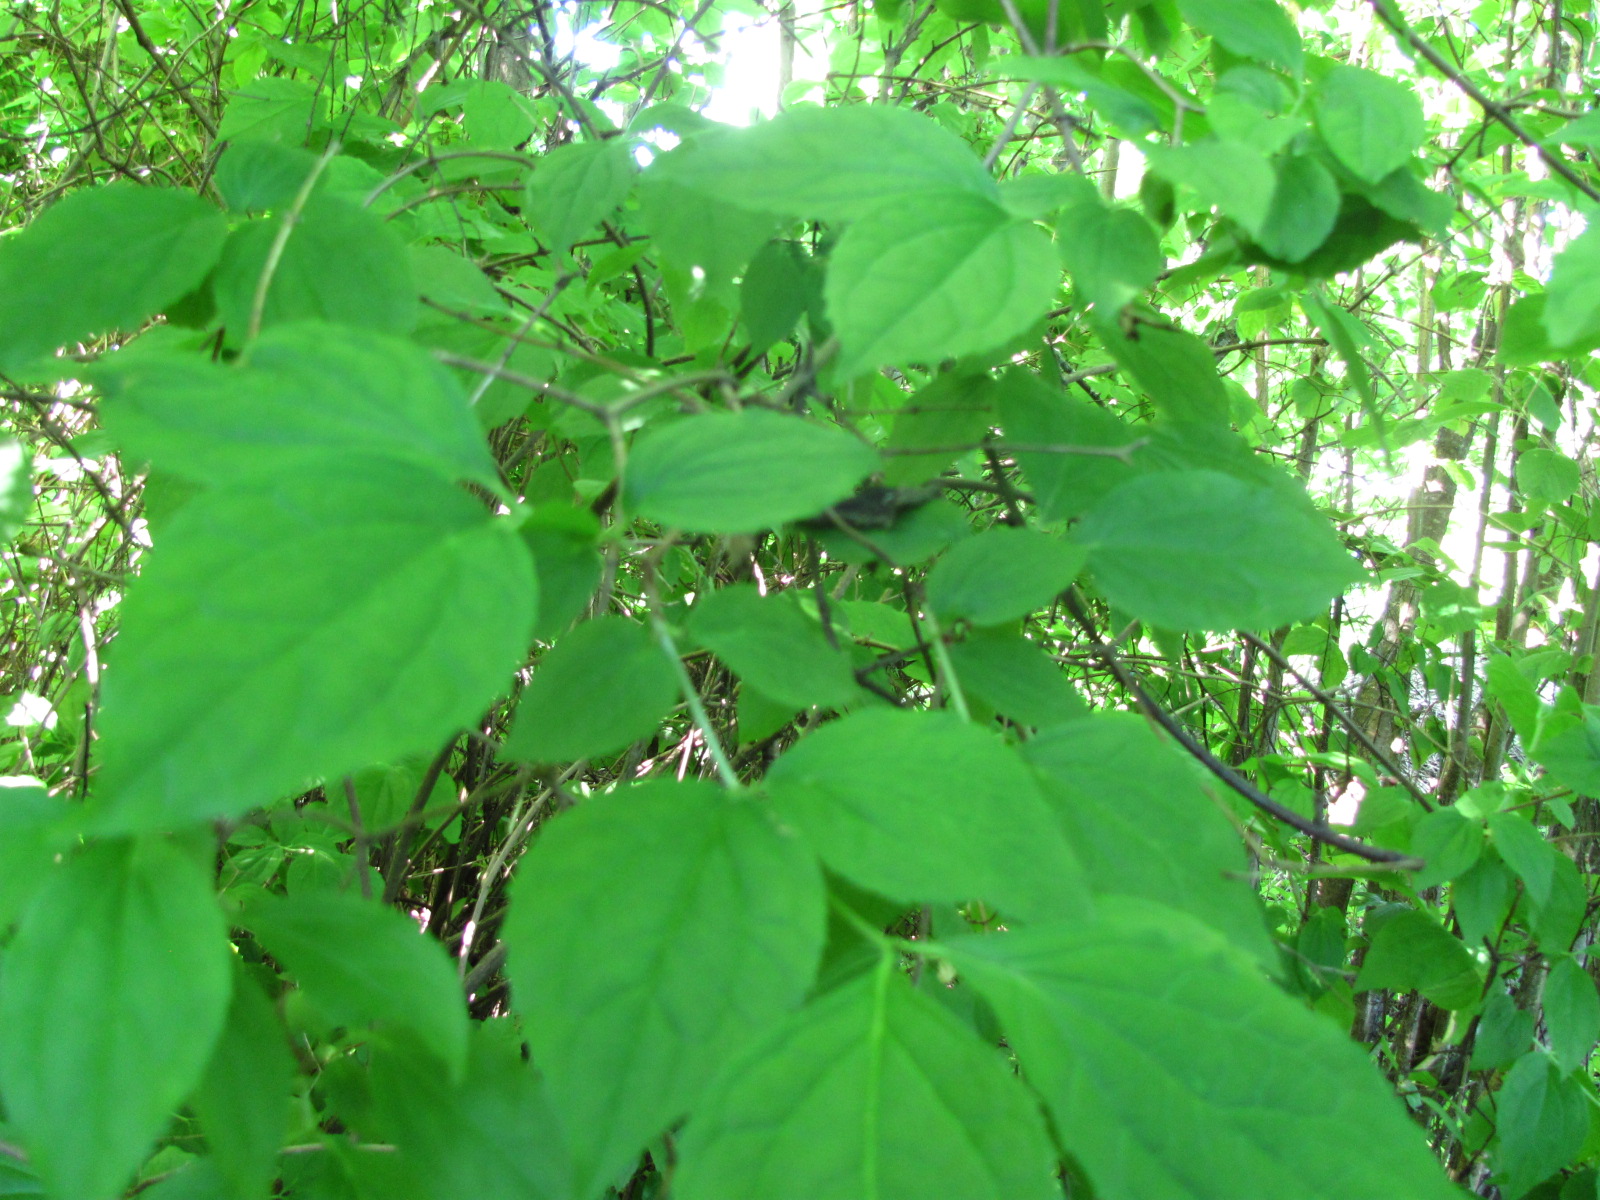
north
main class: Woodland
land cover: Broadleaved woodland
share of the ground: > 75 %
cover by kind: broadleaved forest trees 100 %
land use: Residential
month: June
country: LV
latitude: 56.4475
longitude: 24.2533
